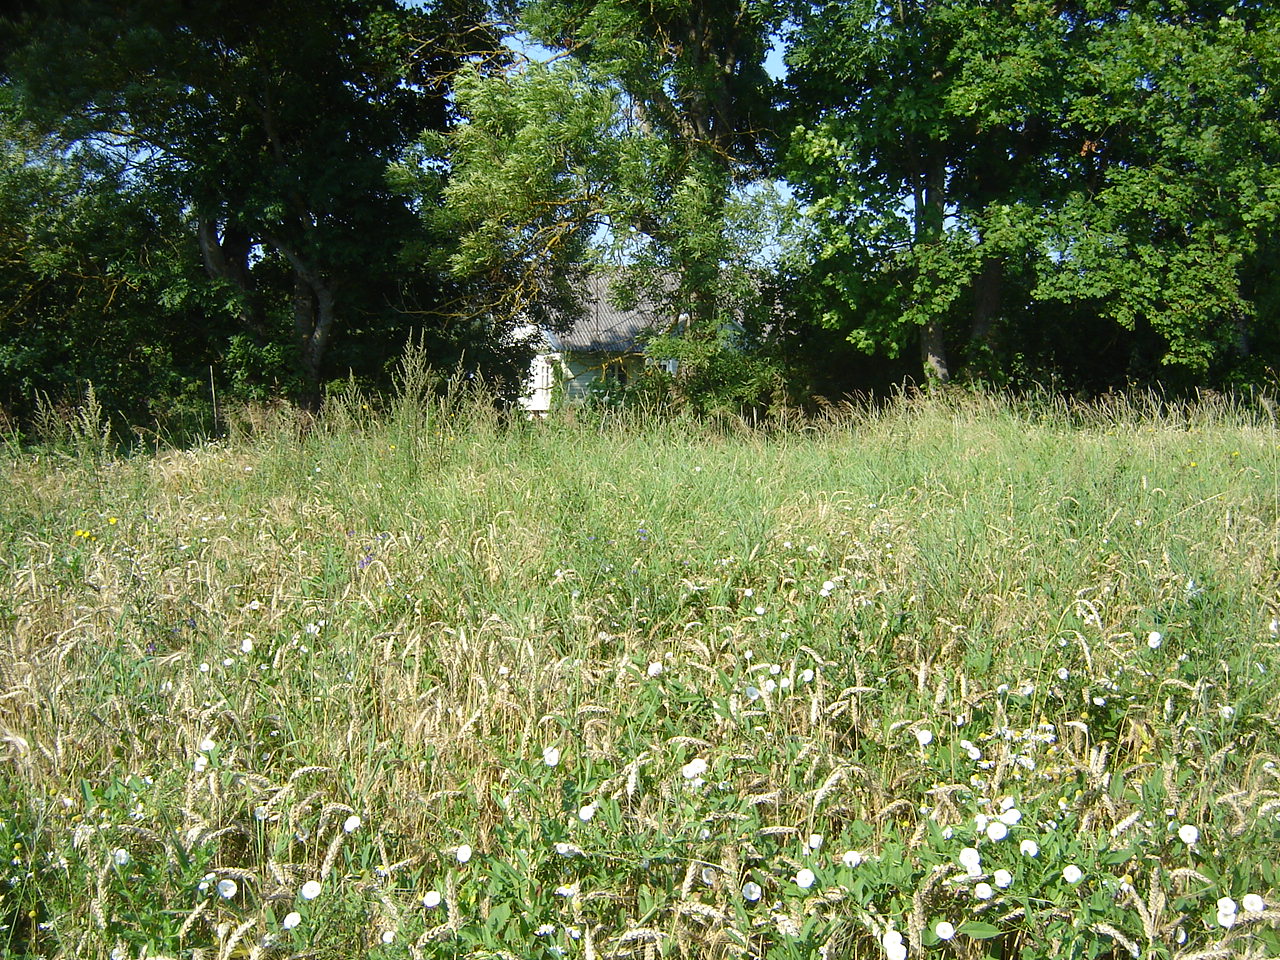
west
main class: Cropland
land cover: Common wheat
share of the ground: > 75 %
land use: Agriculture (excluding fallow land and kitchen gardens)
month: August
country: LT
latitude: 55.1191
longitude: 25.1214
